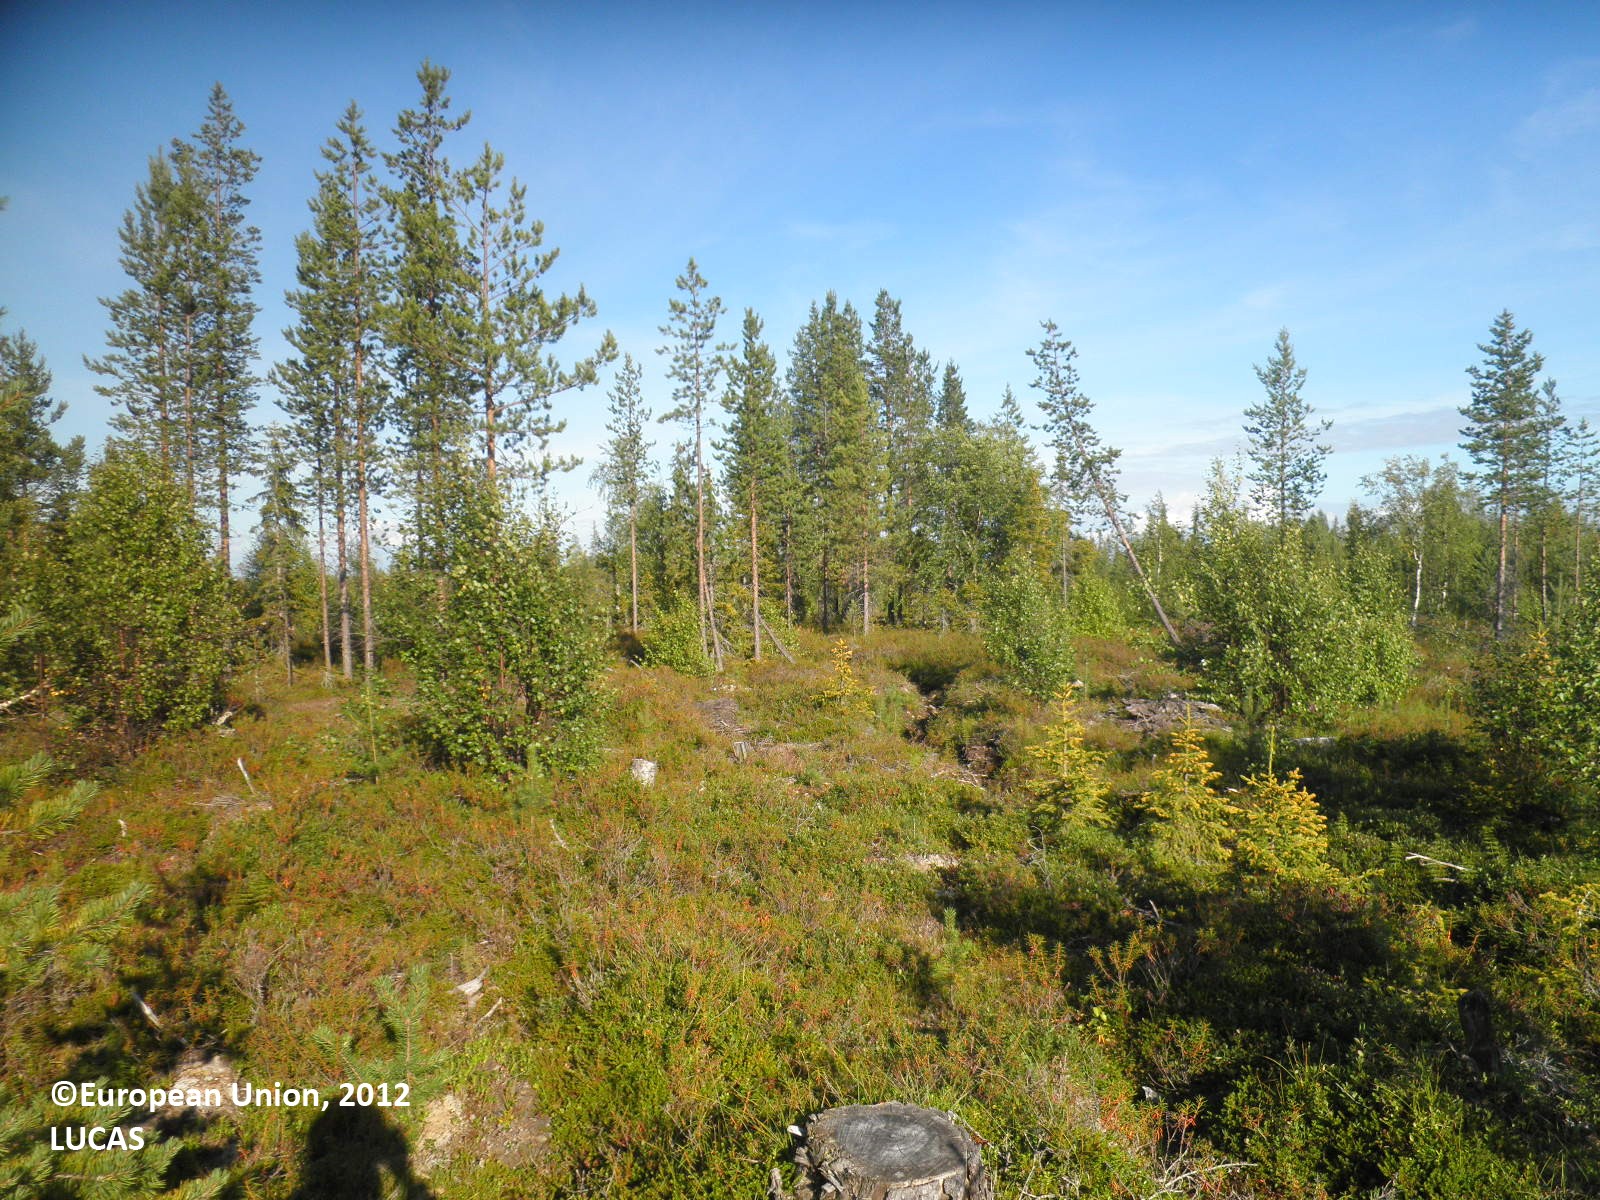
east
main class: Woodland
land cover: Pine dominated mixed woodland
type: boreal forest
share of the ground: 25 - 50 %
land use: Forestry
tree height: < 5 m
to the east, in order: Pine dominated mixed woodland; Ditches and canals; Shrubland with sparse tree cover; Ditches and canals; Shrubland with sparse tree cover; Ditches and canals; Shrubland without tree cover; Pine dominated mixed woodland; Pine dominated coniferous woodland; Peatbogs
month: August
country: FI
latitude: 67.6348
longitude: 27.0630
